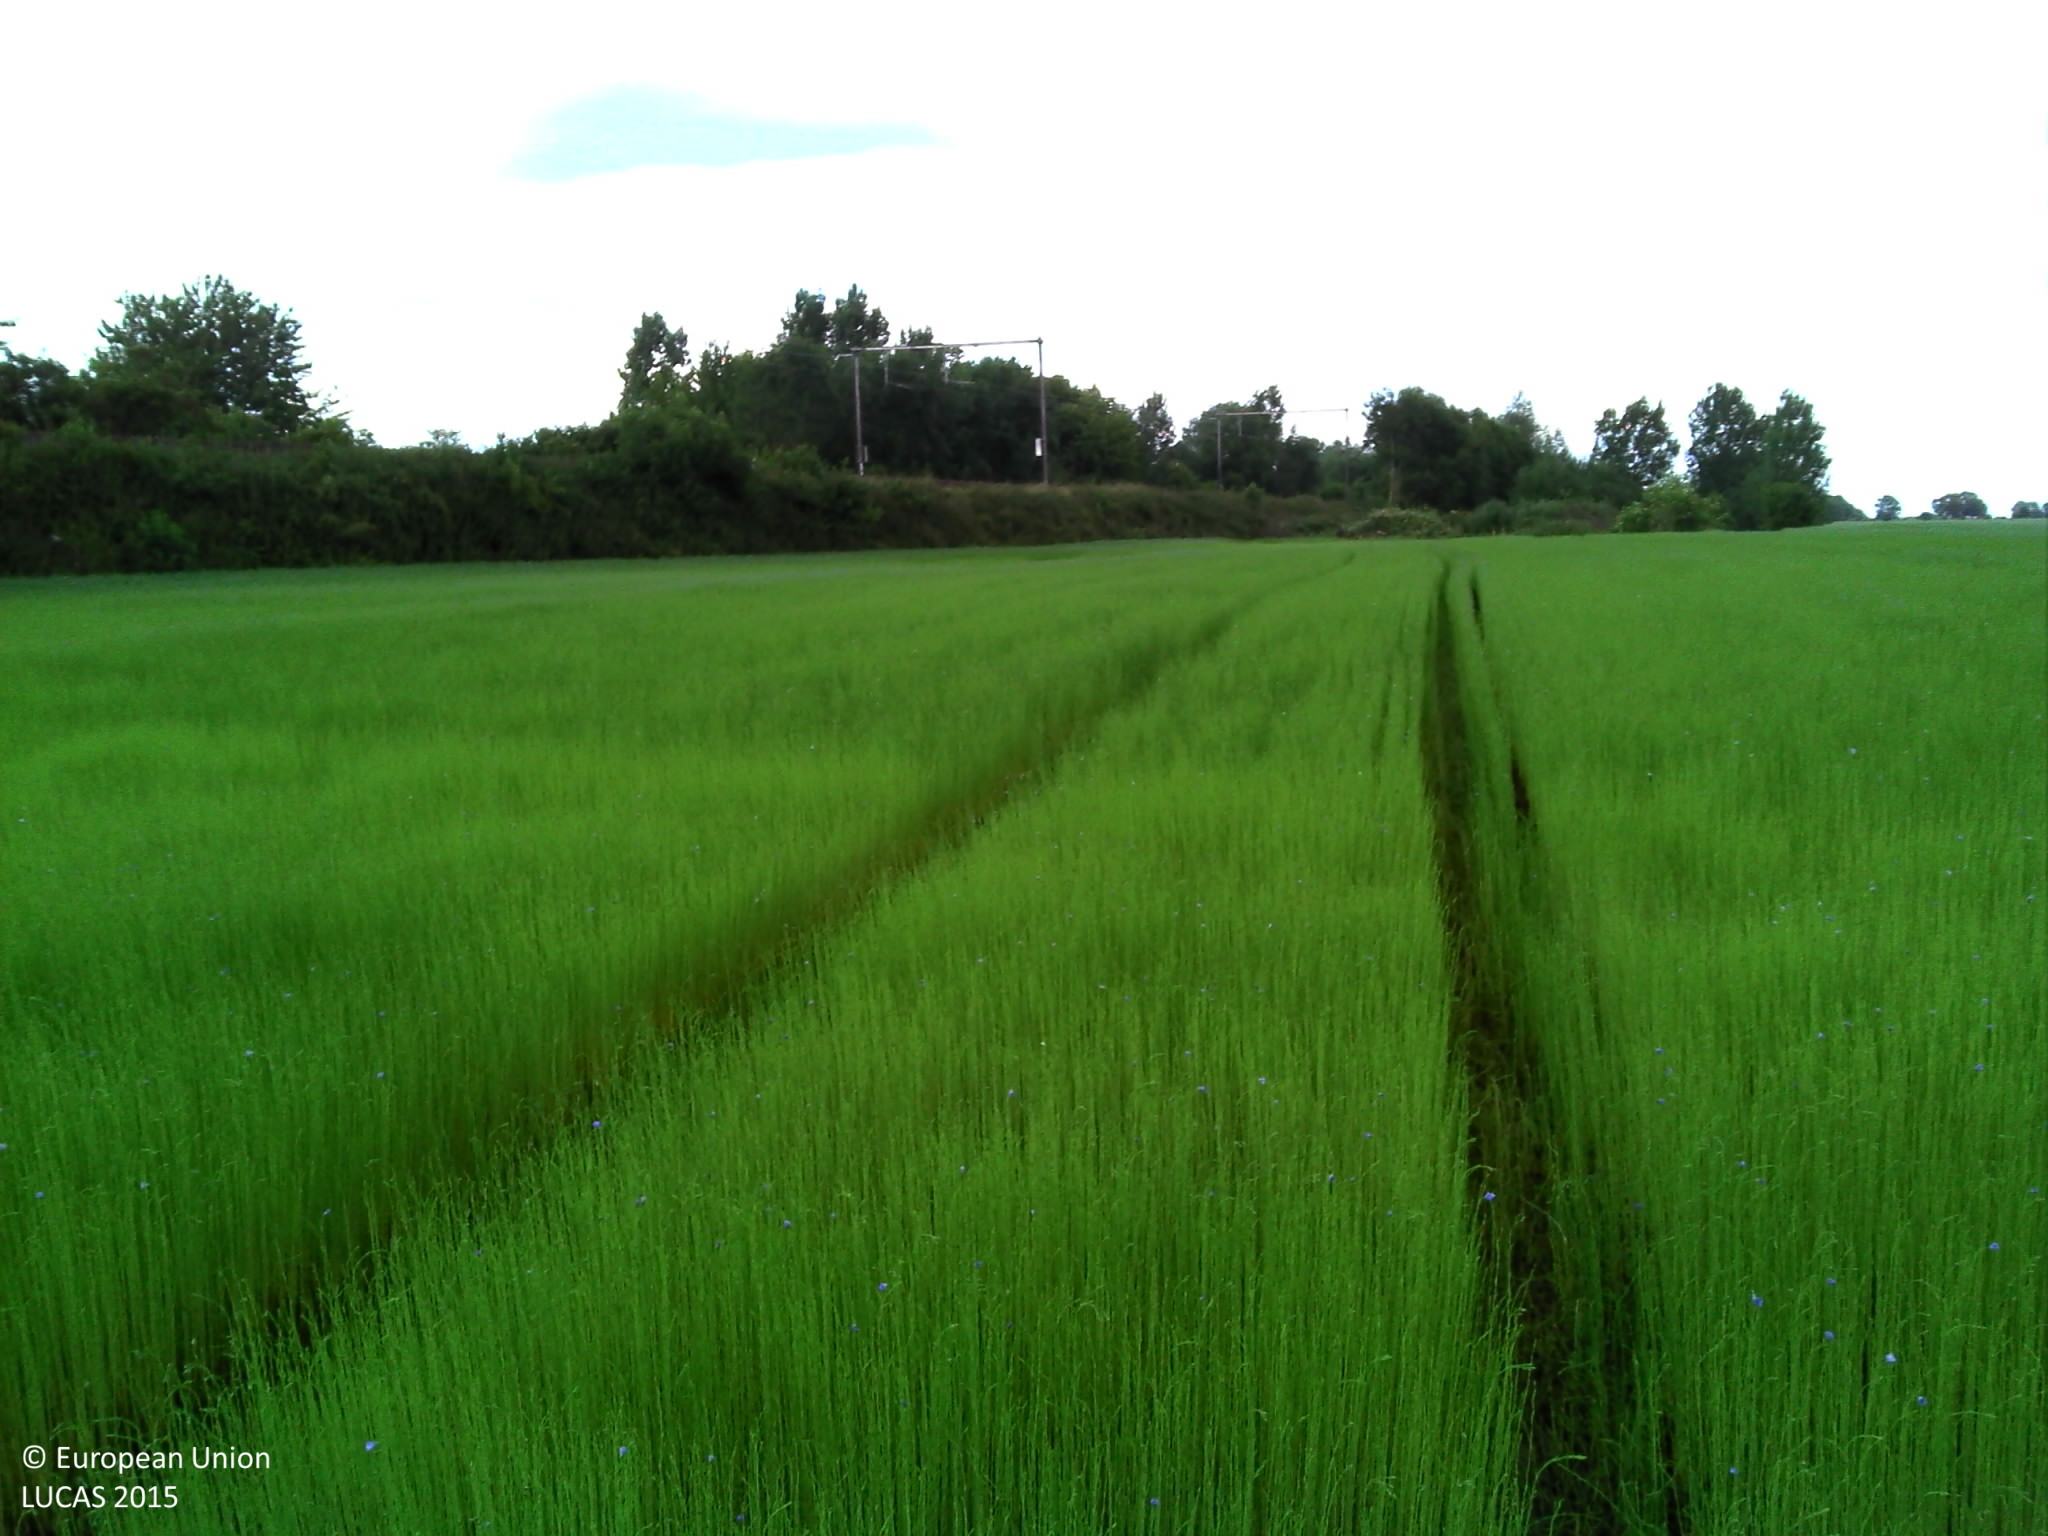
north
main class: Cropland
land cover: Other fibre and oleaginous crops
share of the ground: > 75 %
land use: Agriculture (excluding fallow land and kitchen gardens)
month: June
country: BE
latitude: 50.5504
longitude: 4.0243
